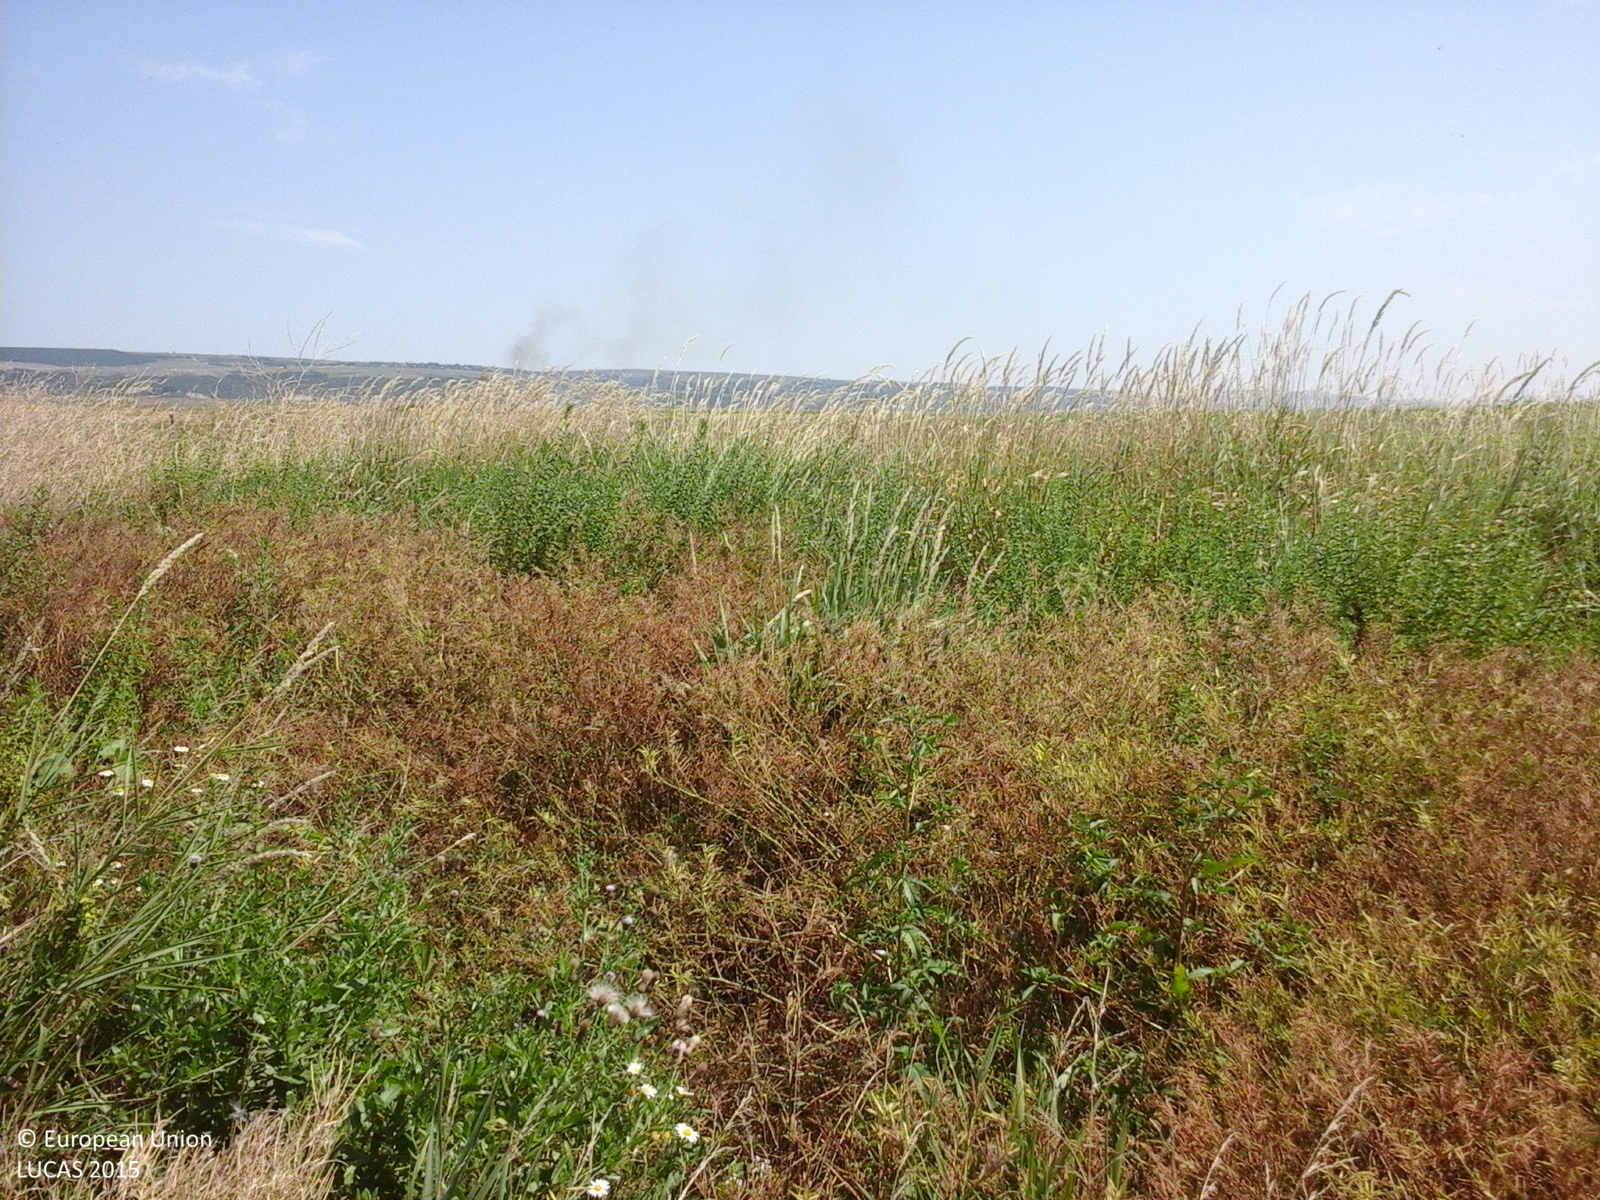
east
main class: Grassland
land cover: Spontaneously vegetated surfaces
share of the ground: > 75 %
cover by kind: herbaceous plants 100 %
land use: Fallow land
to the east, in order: Spontaneously vegetated surfaces; Ditches and canals; Grass margins; Common wheat
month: August
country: RO
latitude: 46.2269
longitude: 27.1210
